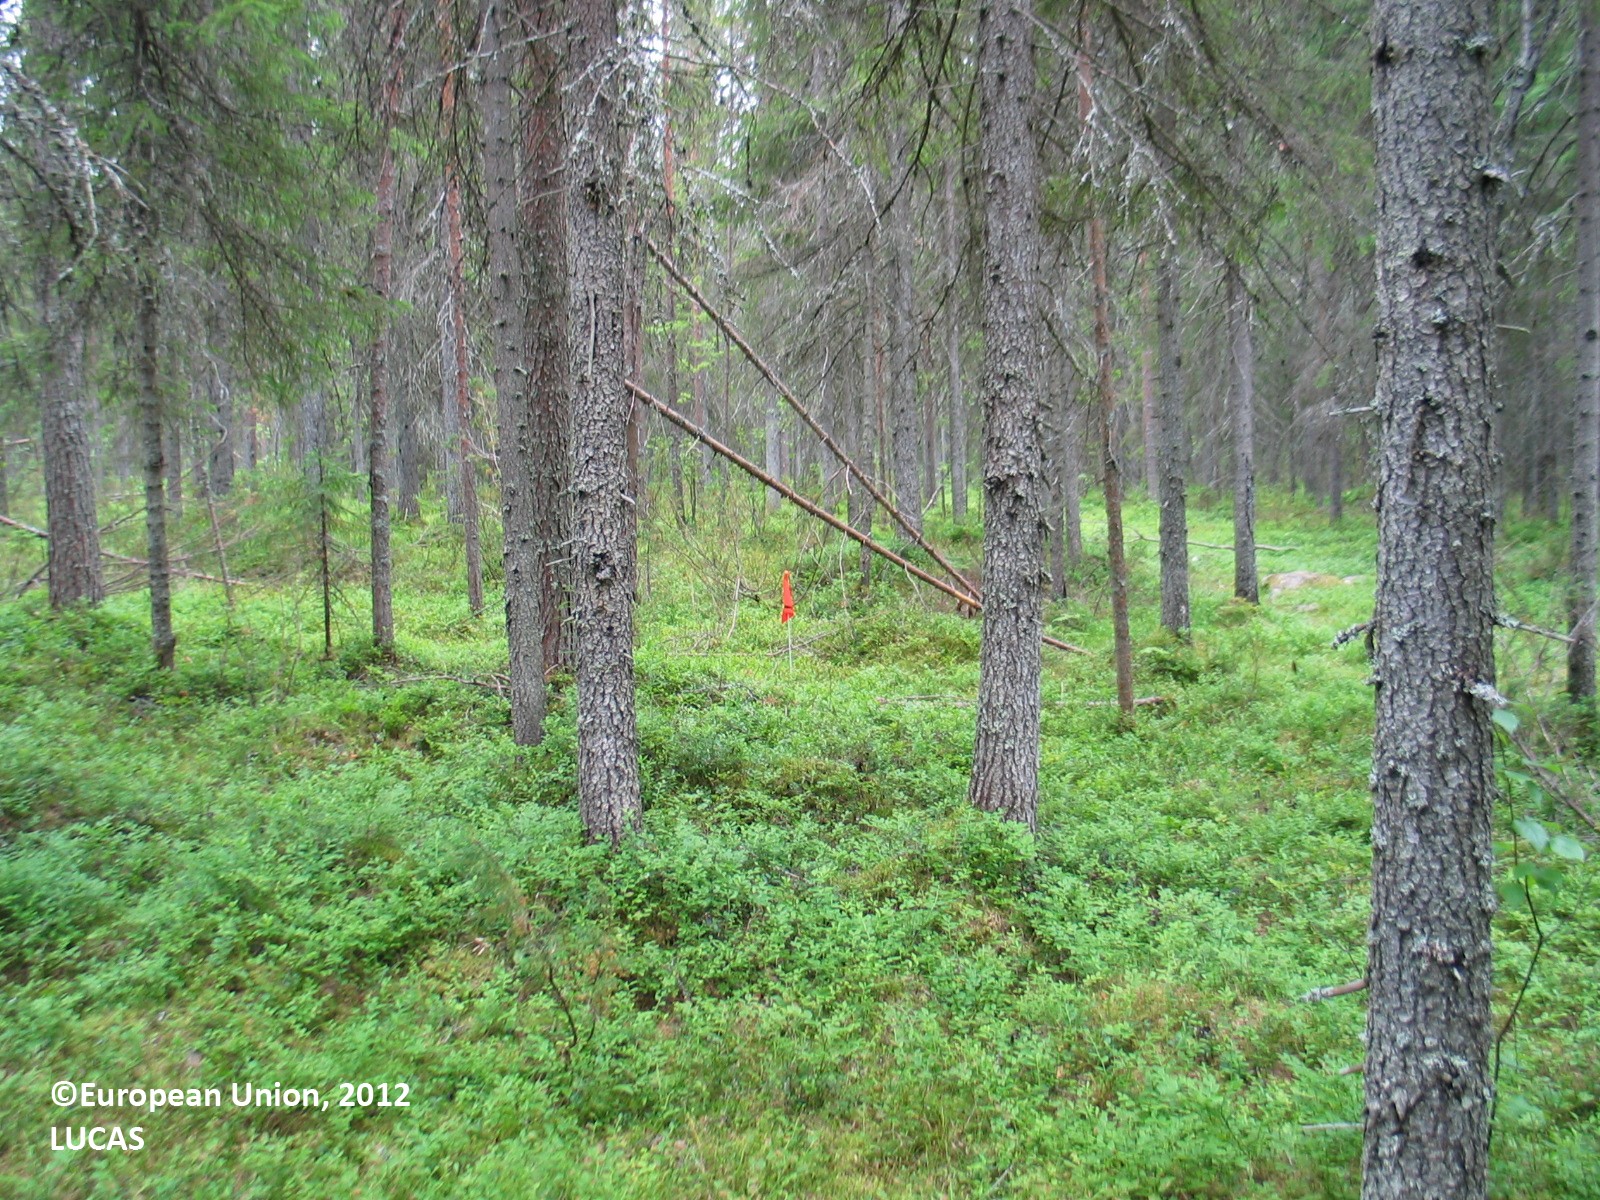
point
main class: Woodland
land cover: Spruce dominated coniferous woodland
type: boreal forest
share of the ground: 50 - 75 %
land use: Forestry
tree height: > 5 m
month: July
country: FI
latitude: 65.7633
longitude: 25.2412
